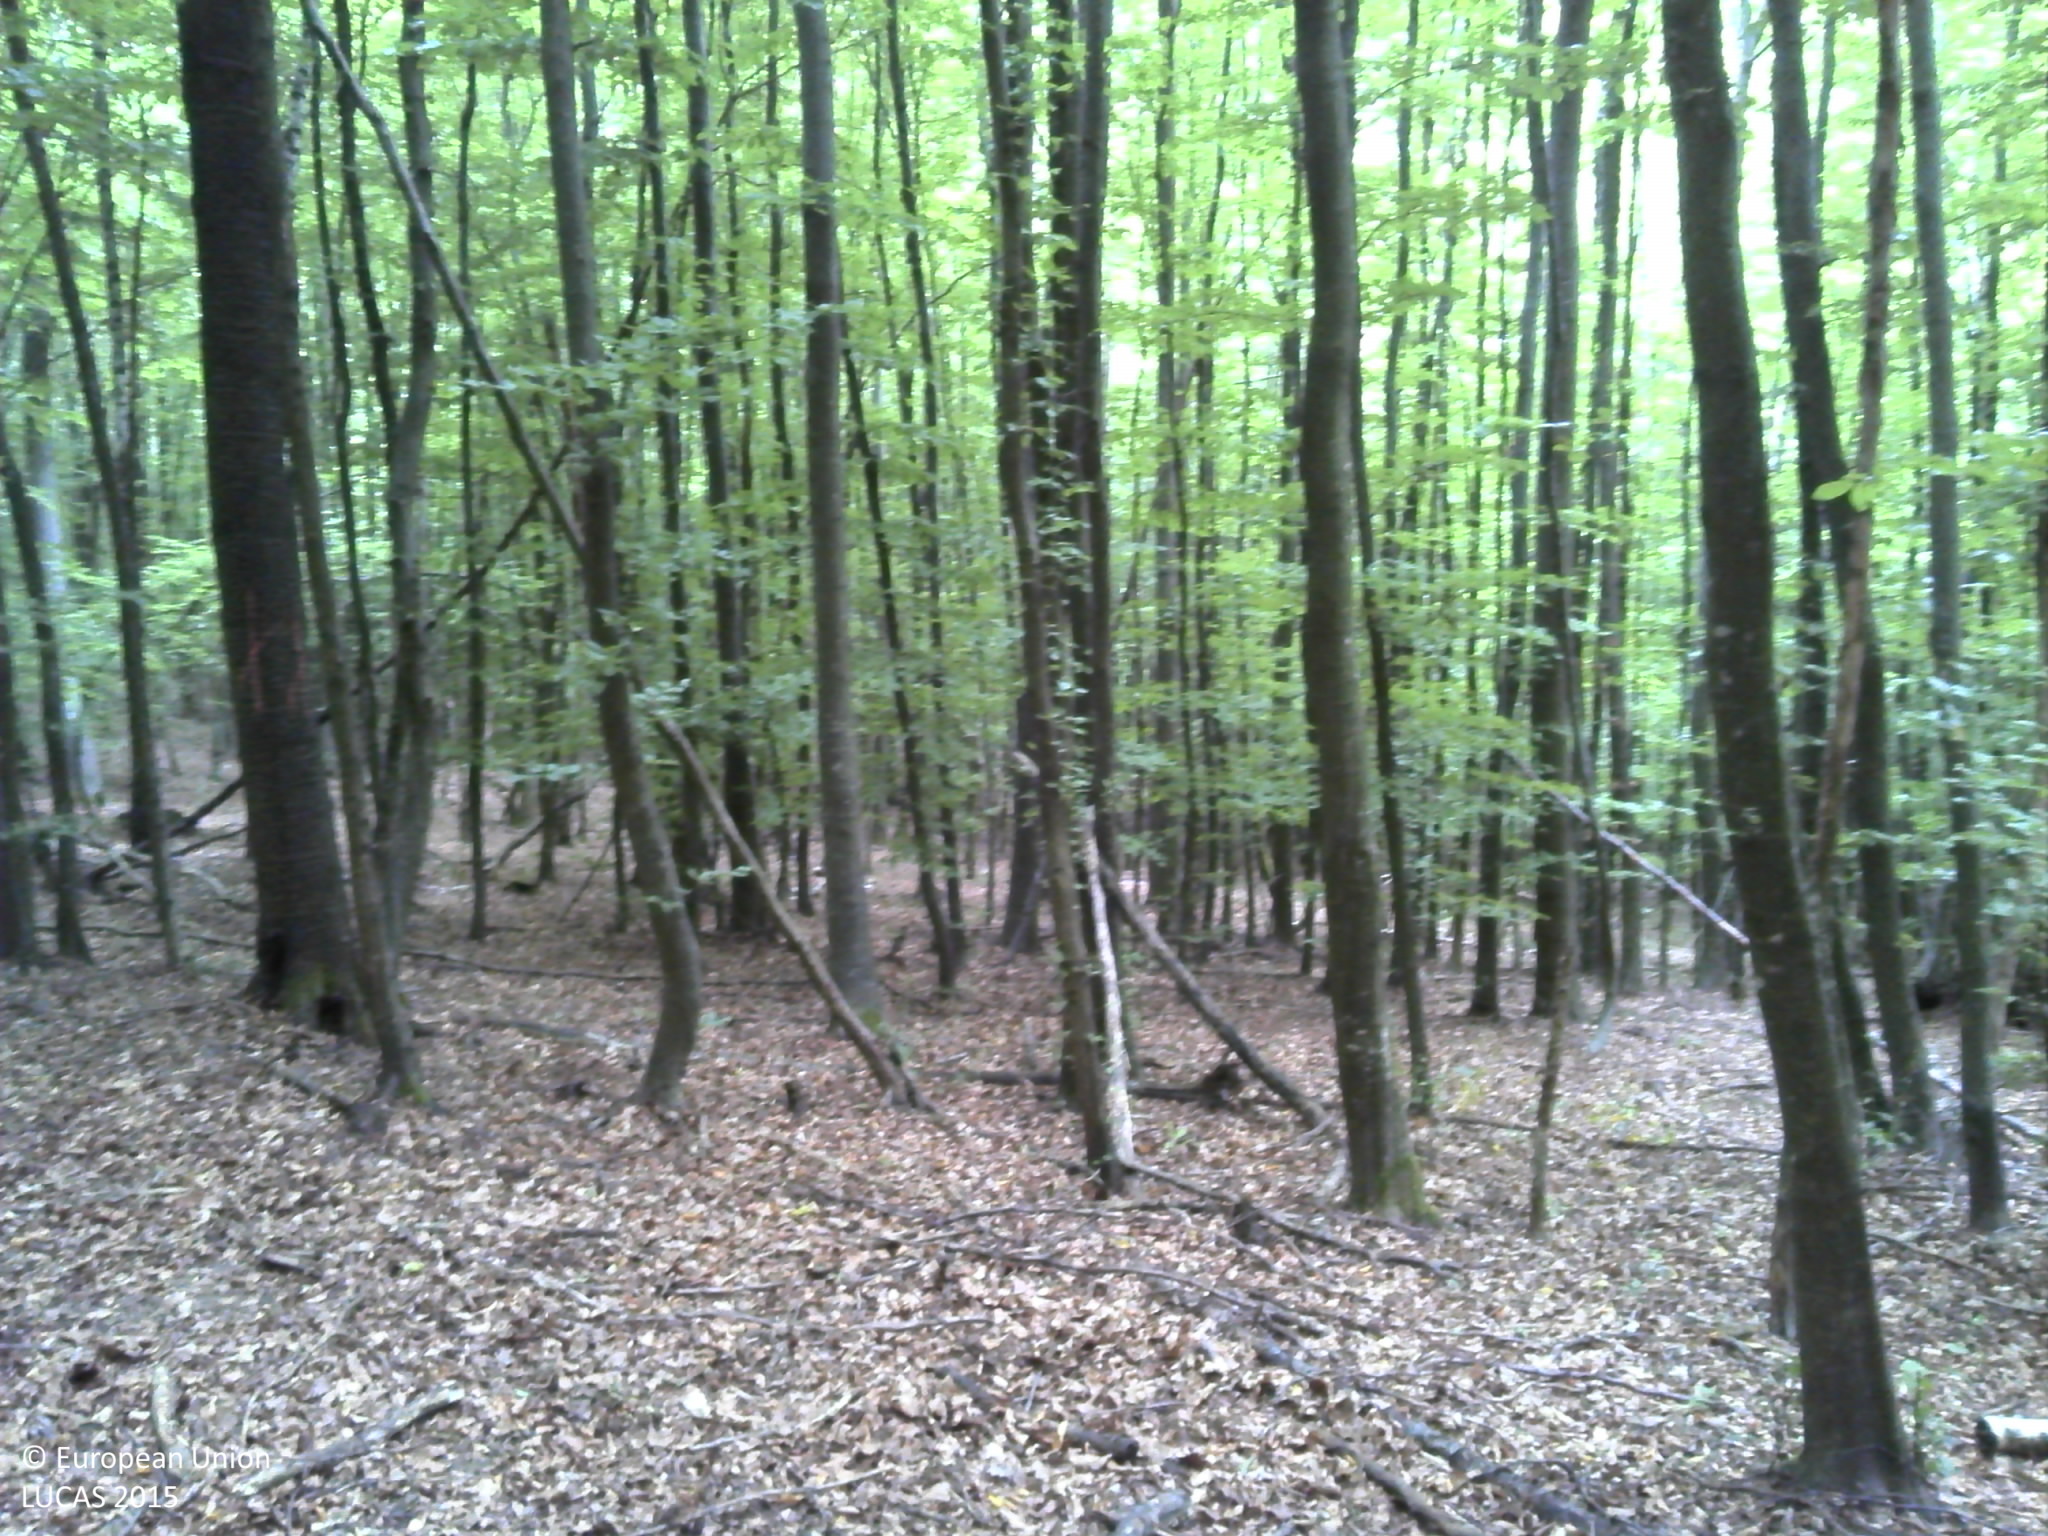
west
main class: Woodland
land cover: Broadleaved woodland
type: beech forest
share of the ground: > 75 %
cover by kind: broadleaved forest trees 80 %, lichens and mosses 20 %
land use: Forestry
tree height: > 5 m
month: June
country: HR
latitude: 45.4738
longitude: 17.4845
